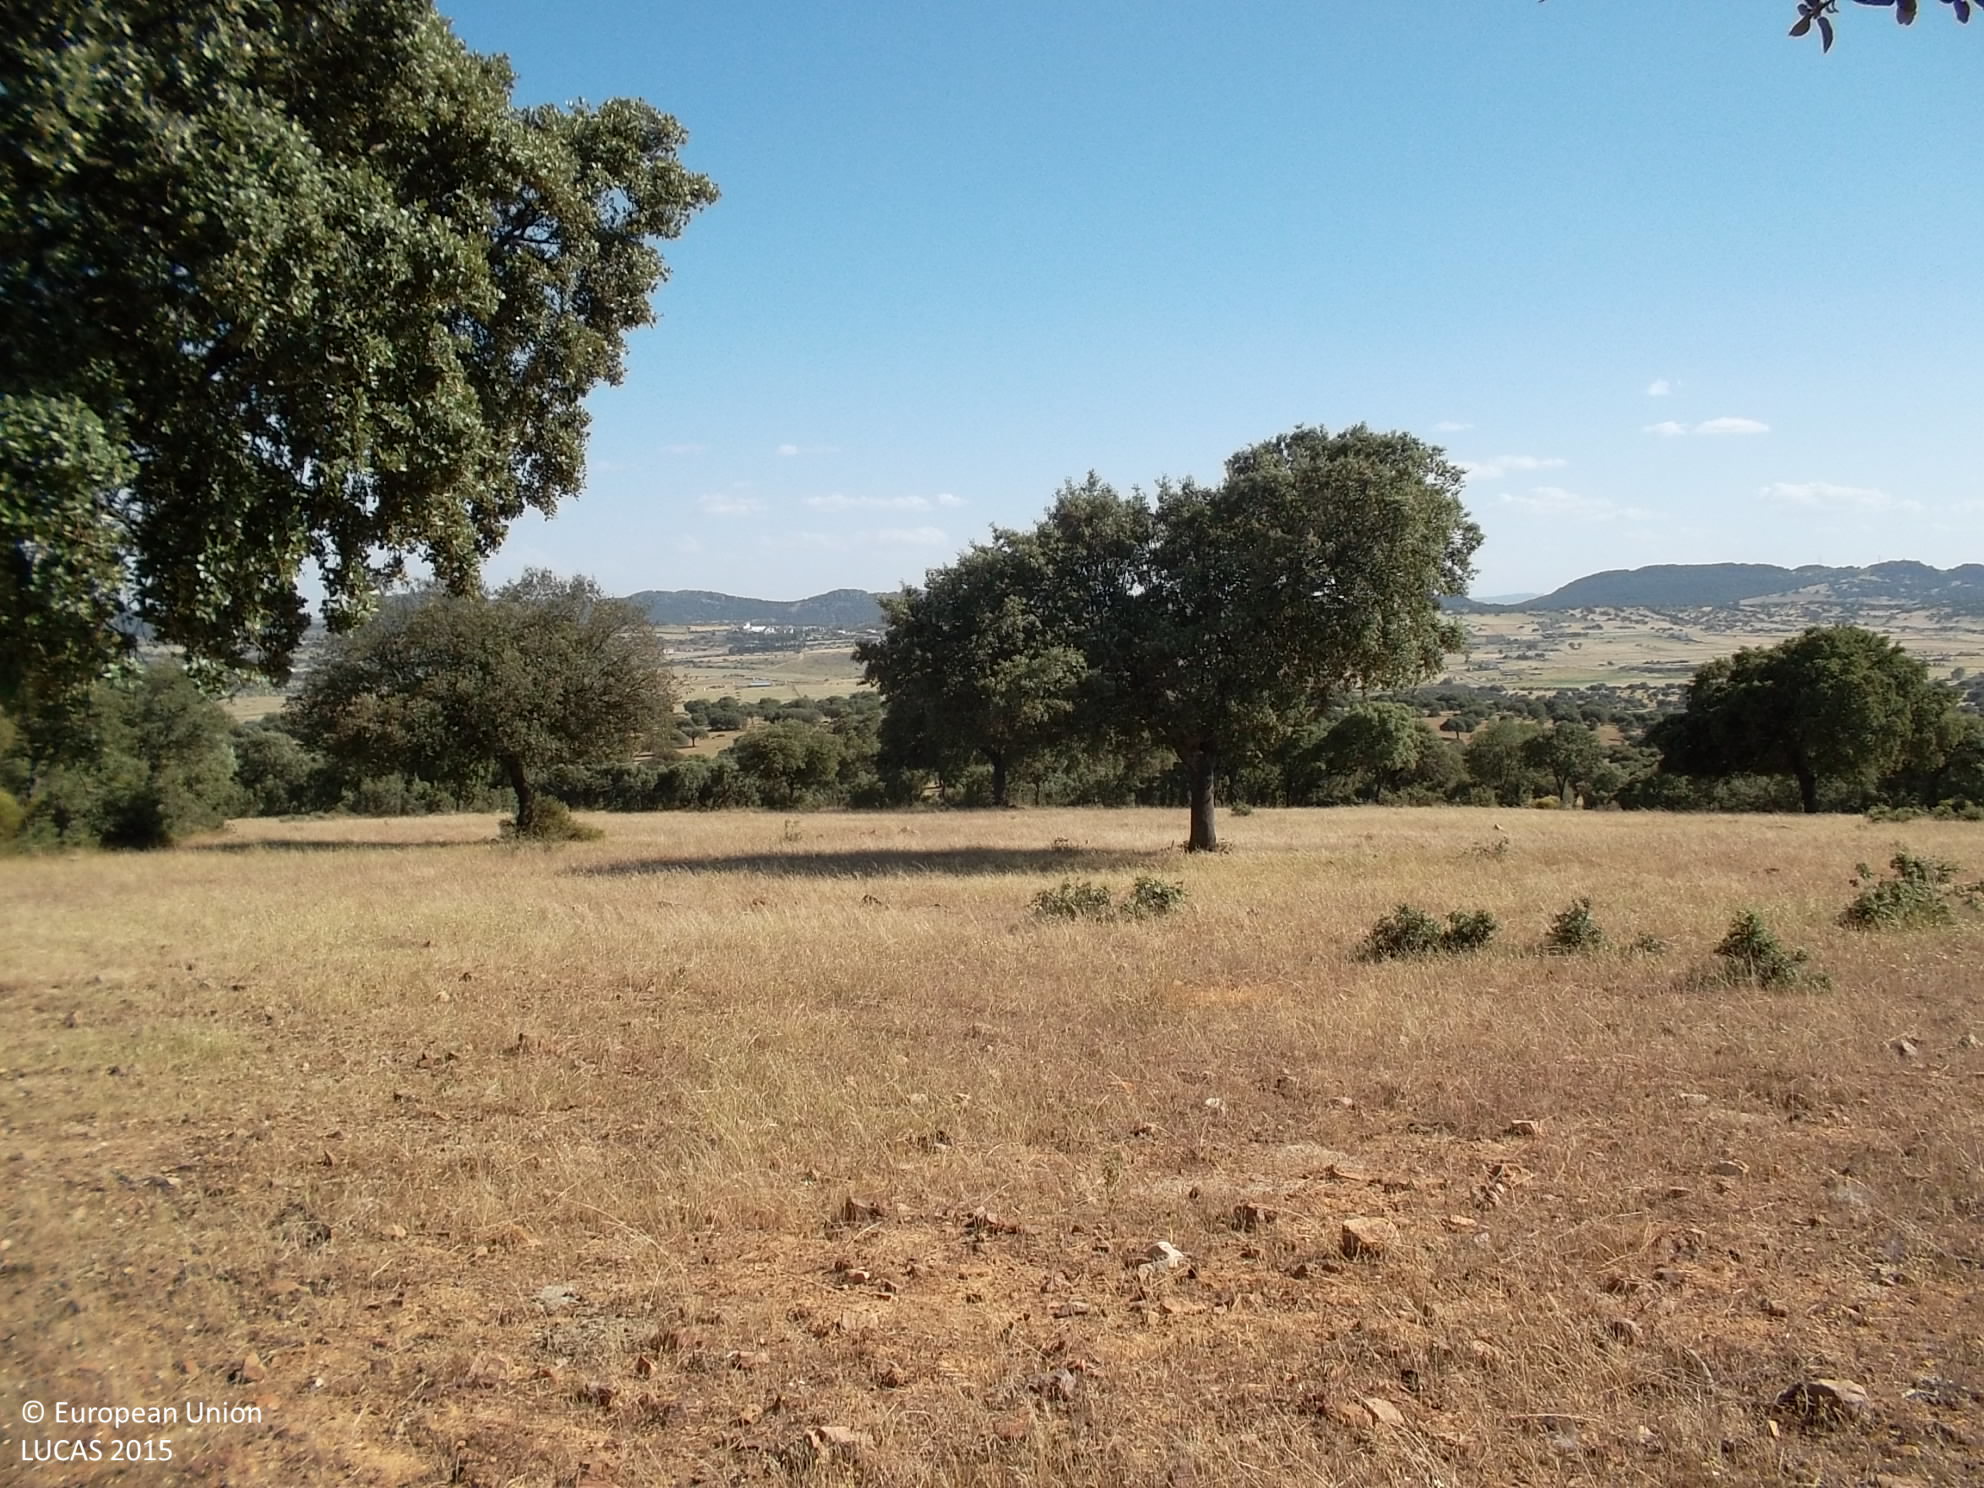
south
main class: Woodland
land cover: Broadleaved woodland
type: broadleaved evergreen forest
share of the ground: 25 - 50 %
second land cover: Spontaneously vegetated surfaces
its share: > 75 %
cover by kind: herbaceous plants 70 %, broadleaved forest trees 30 %
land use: Forestry
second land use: Agriculture (excluding fallow land and kitchen gardens)
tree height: > 5 m
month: May
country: ES
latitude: 38.8210
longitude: -4.8305
